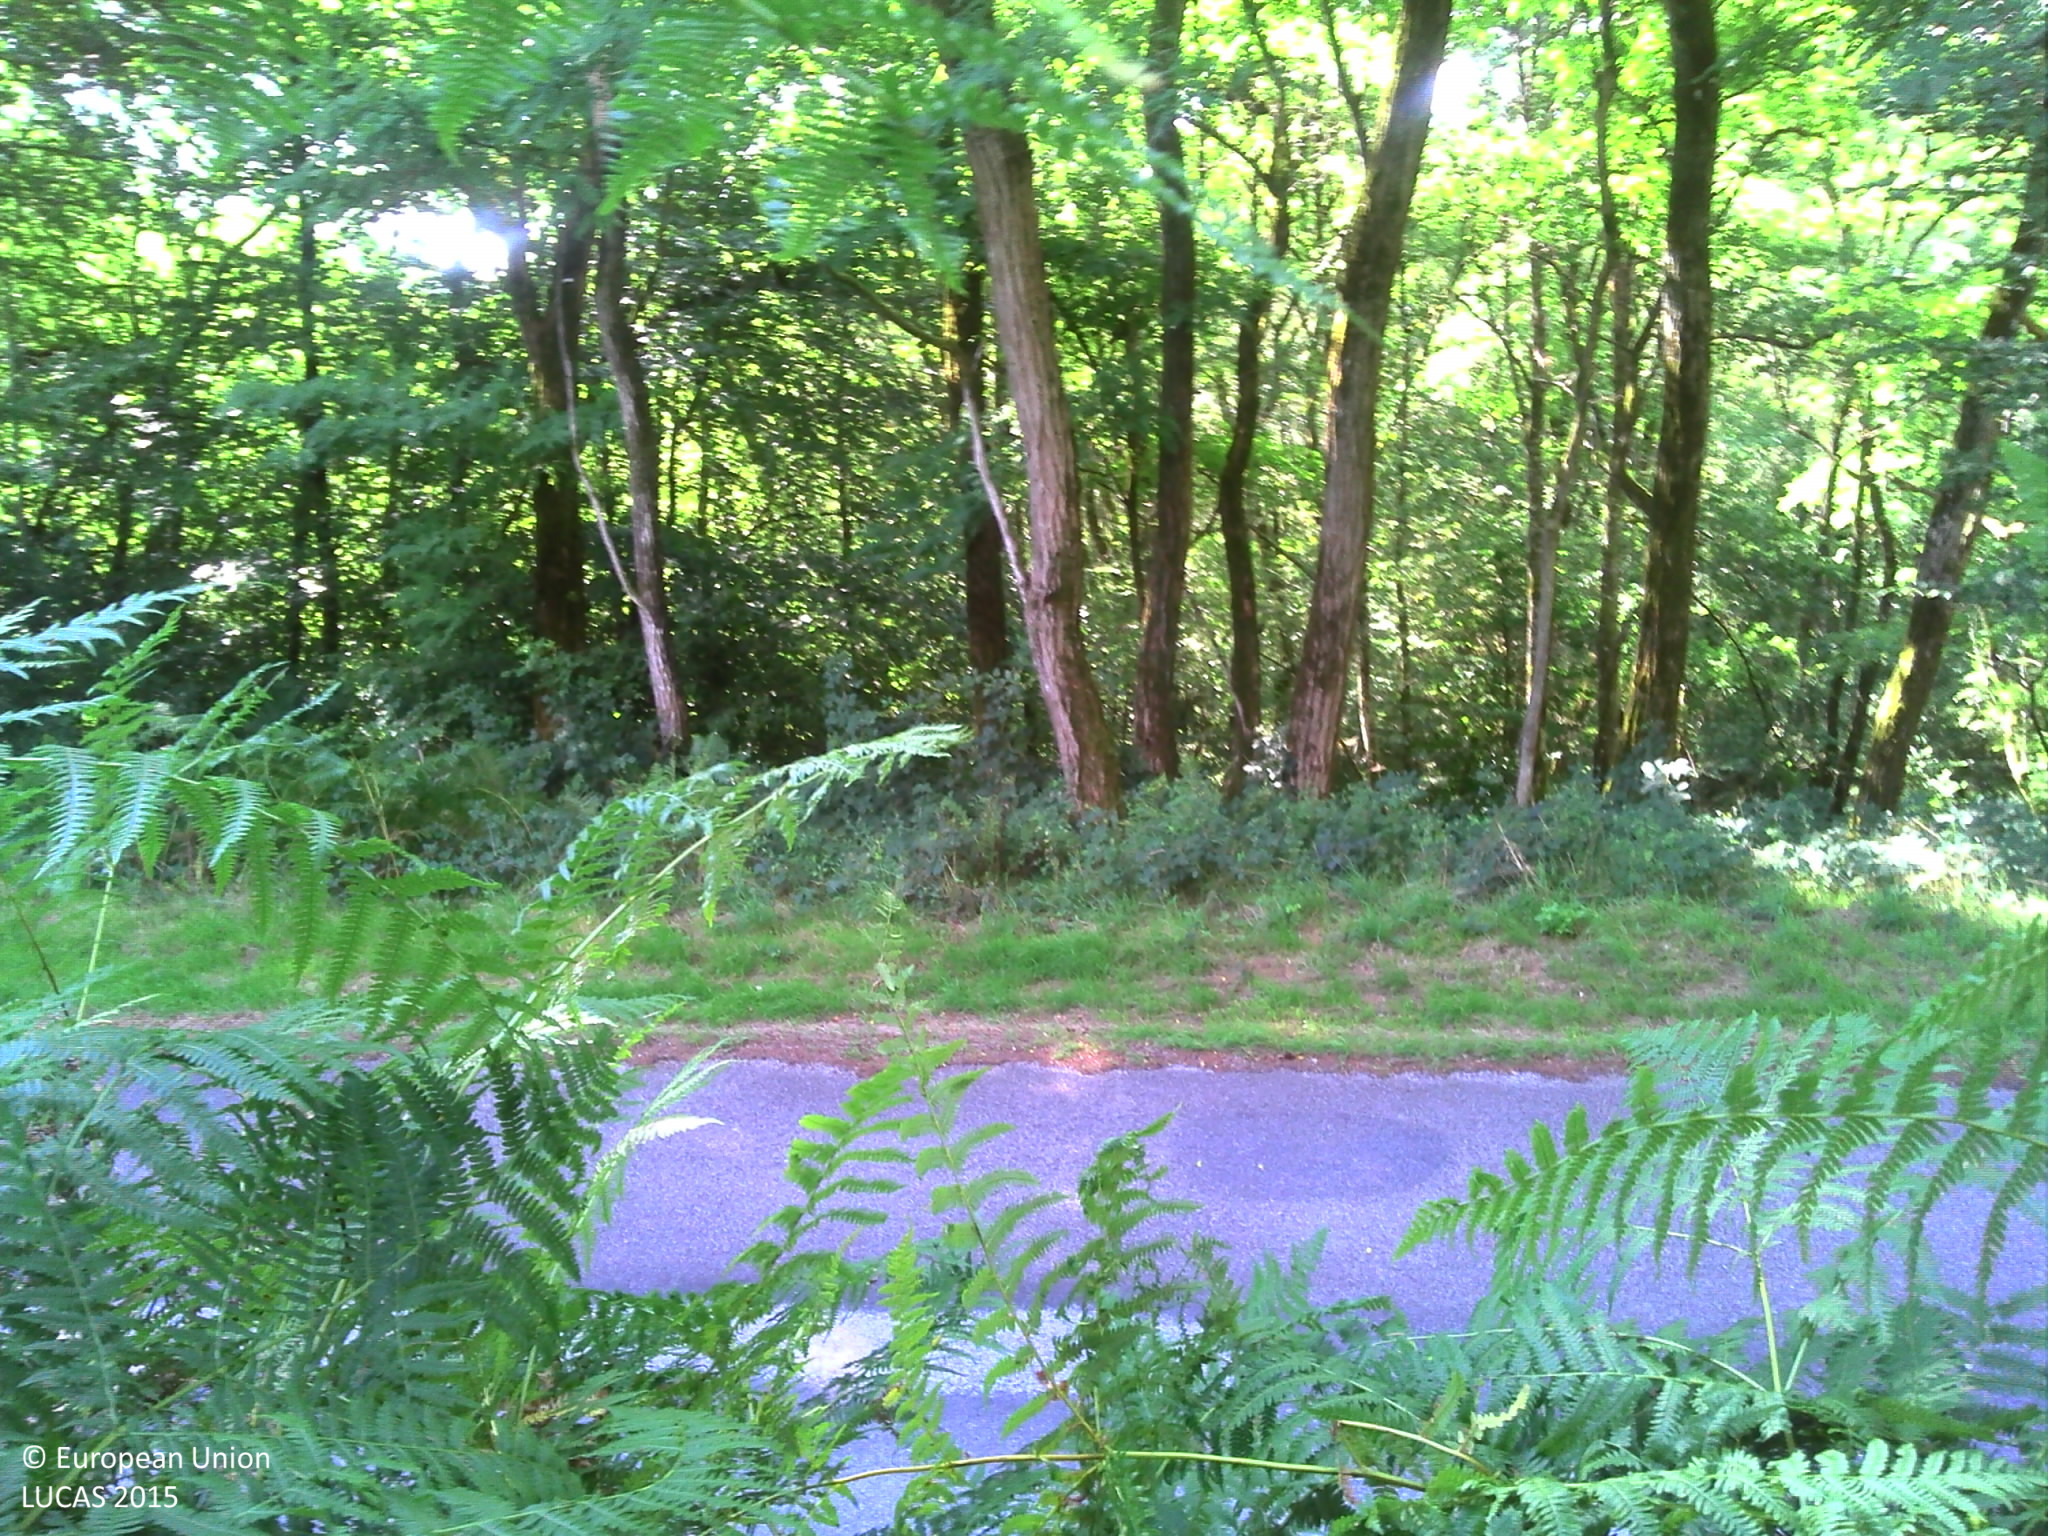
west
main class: Woodland
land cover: Spruce dominated coniferous woodland
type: exotic forest
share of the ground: > 75 %
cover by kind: coniferous forest trees 60 %, shrubs 30 %, broadleaved forest trees 5 %, herbaceous plants 5 %
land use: Forestry
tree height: > 5 m
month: August
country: FR
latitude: 45.8562
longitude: 1.8157
